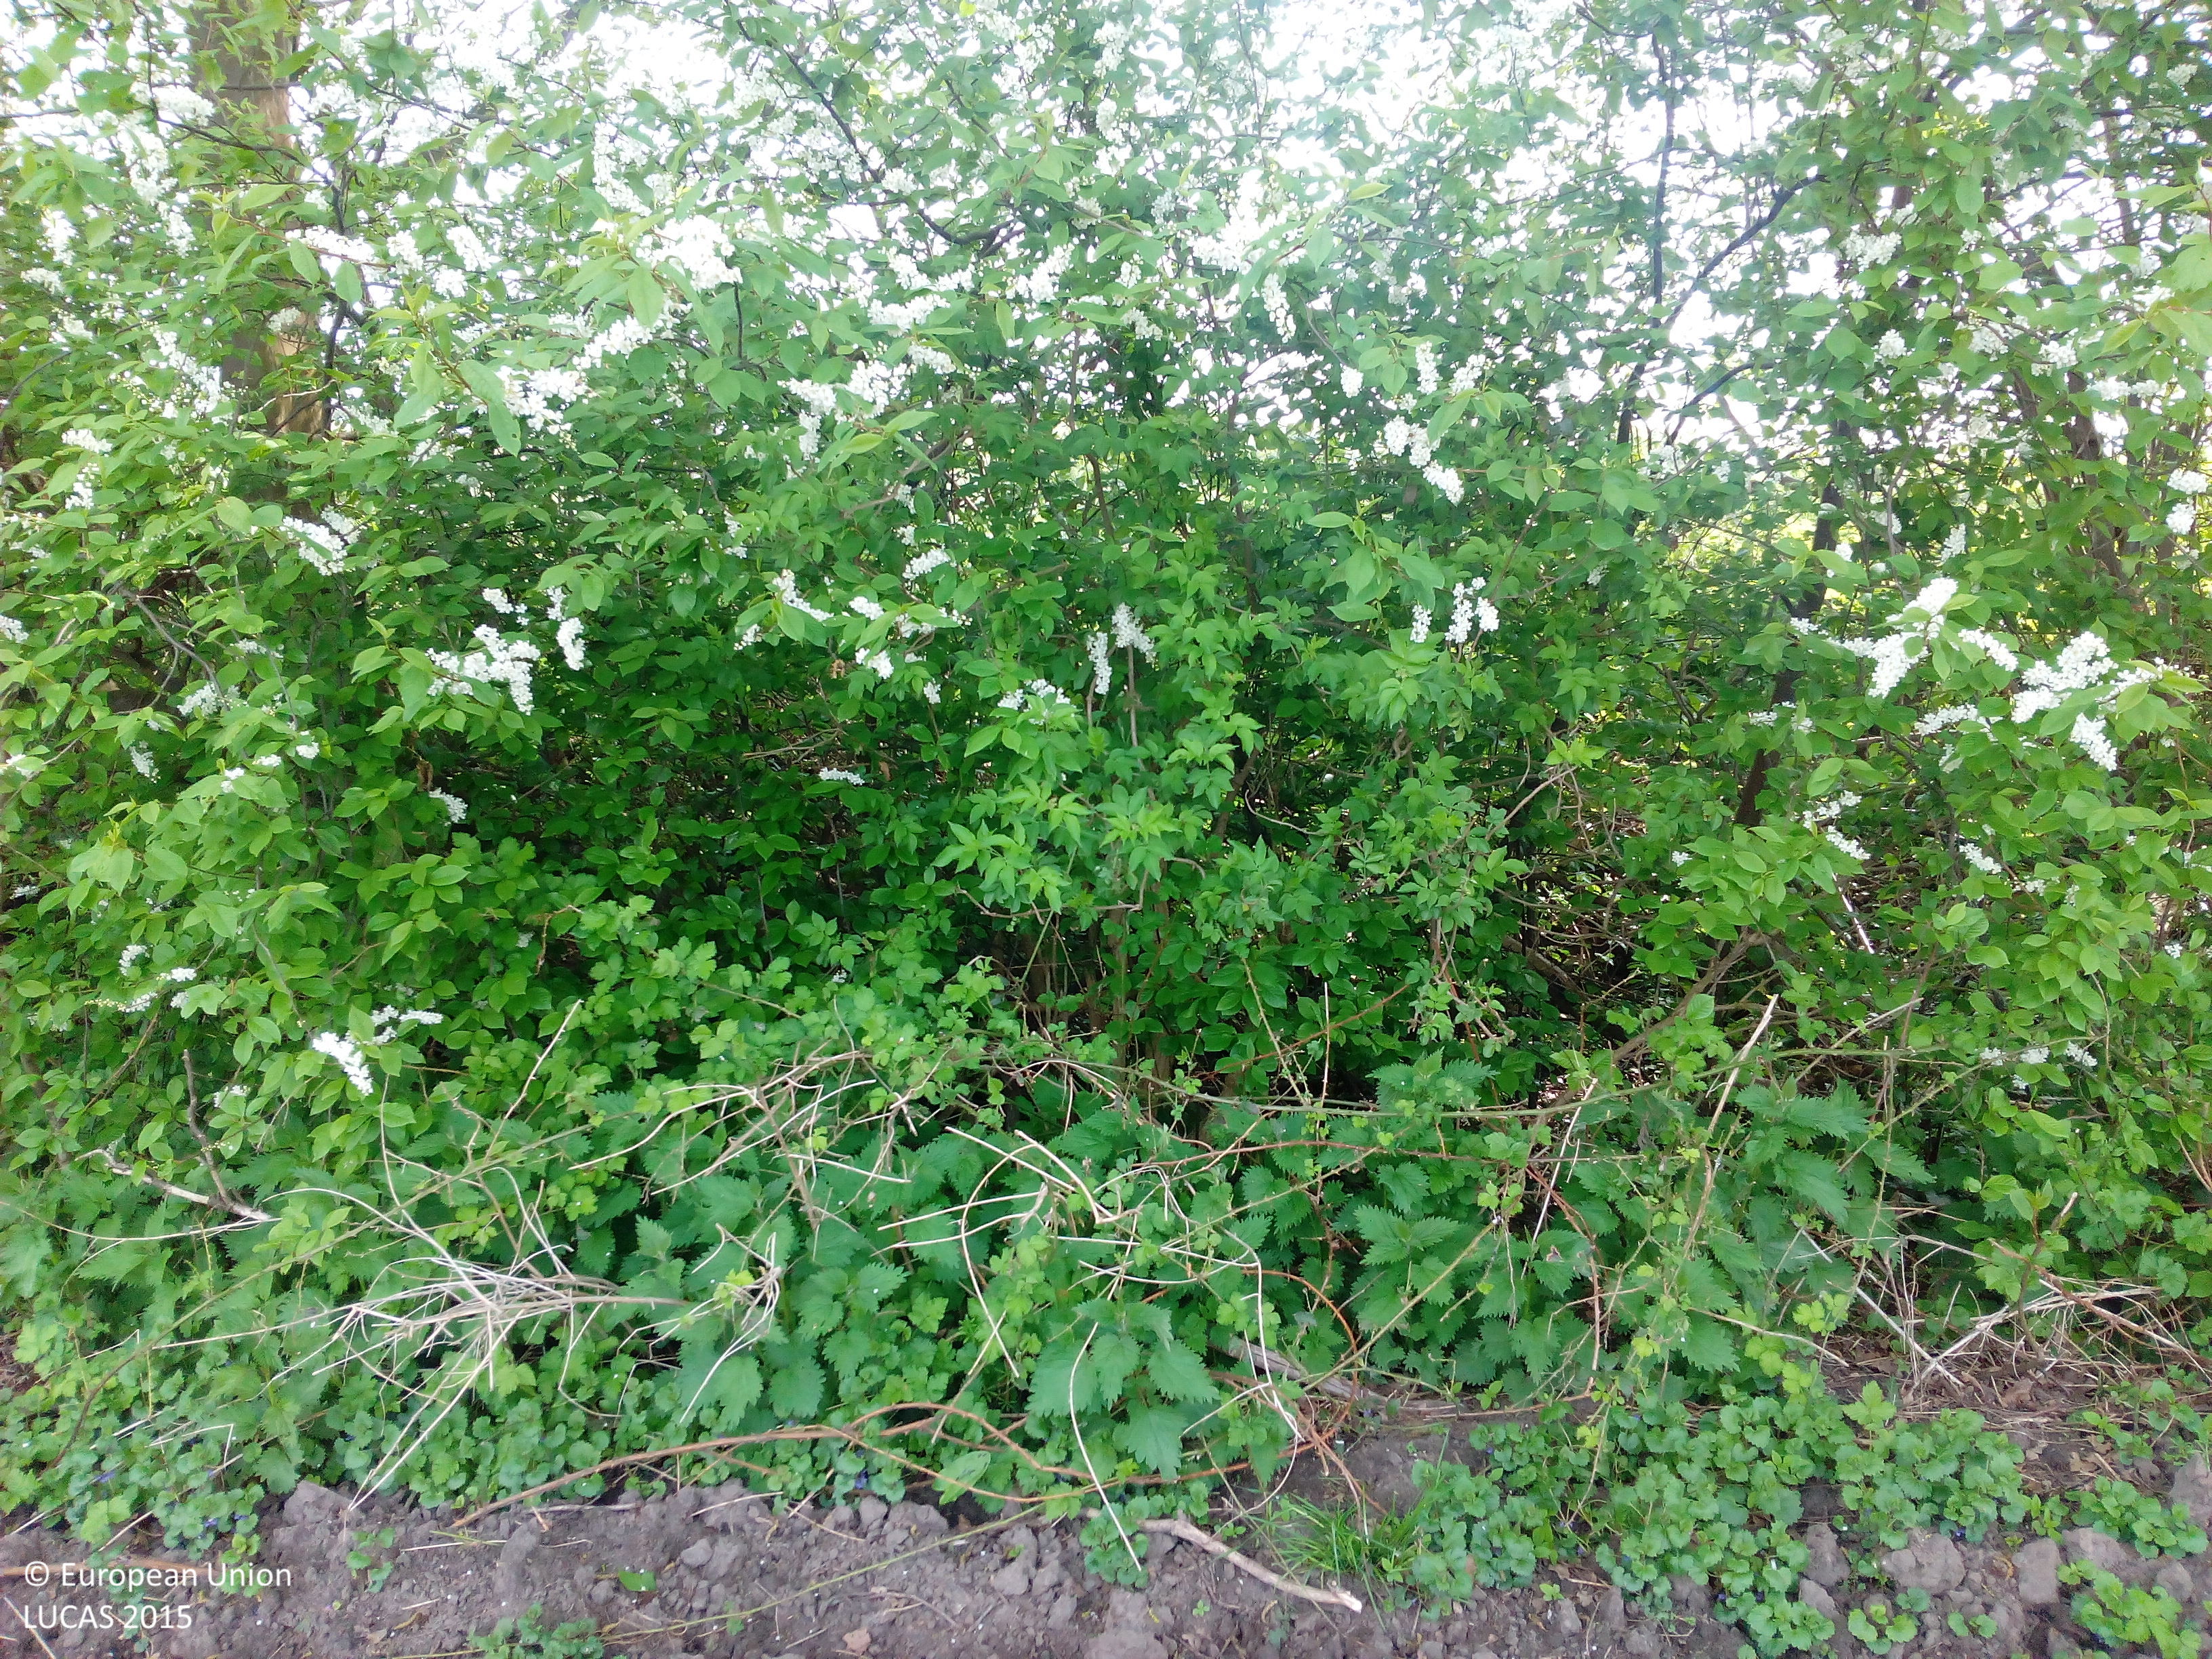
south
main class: Cropland
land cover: Maize
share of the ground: < 10 %
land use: Agriculture (excluding fallow land and kitchen gardens)
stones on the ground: < 10 %
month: May
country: DE
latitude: 52.1509
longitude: 7.3842
